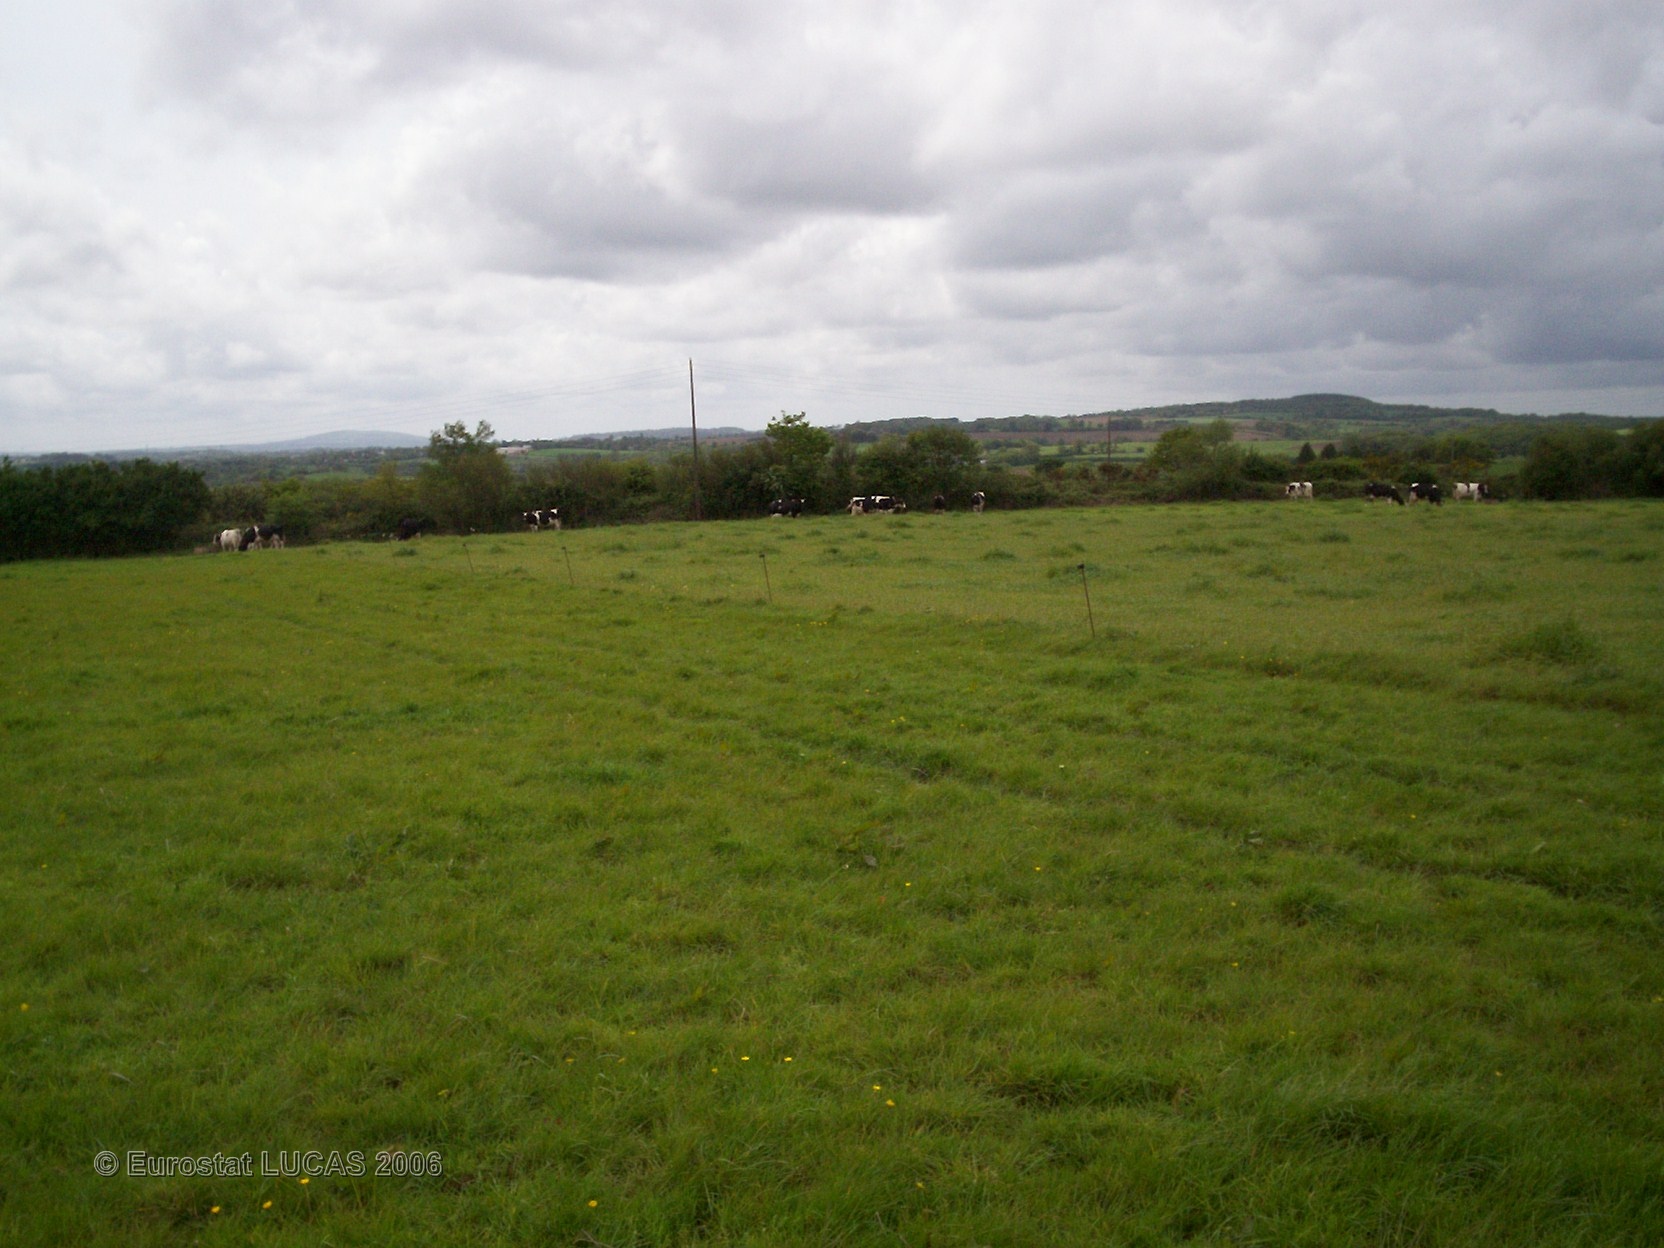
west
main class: Grassland
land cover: Grassland without tree/shrub cover
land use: Agriculture (excluding fallow land and kitchen gardens)
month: May
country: FR
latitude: 48.1181
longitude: -3.9352
